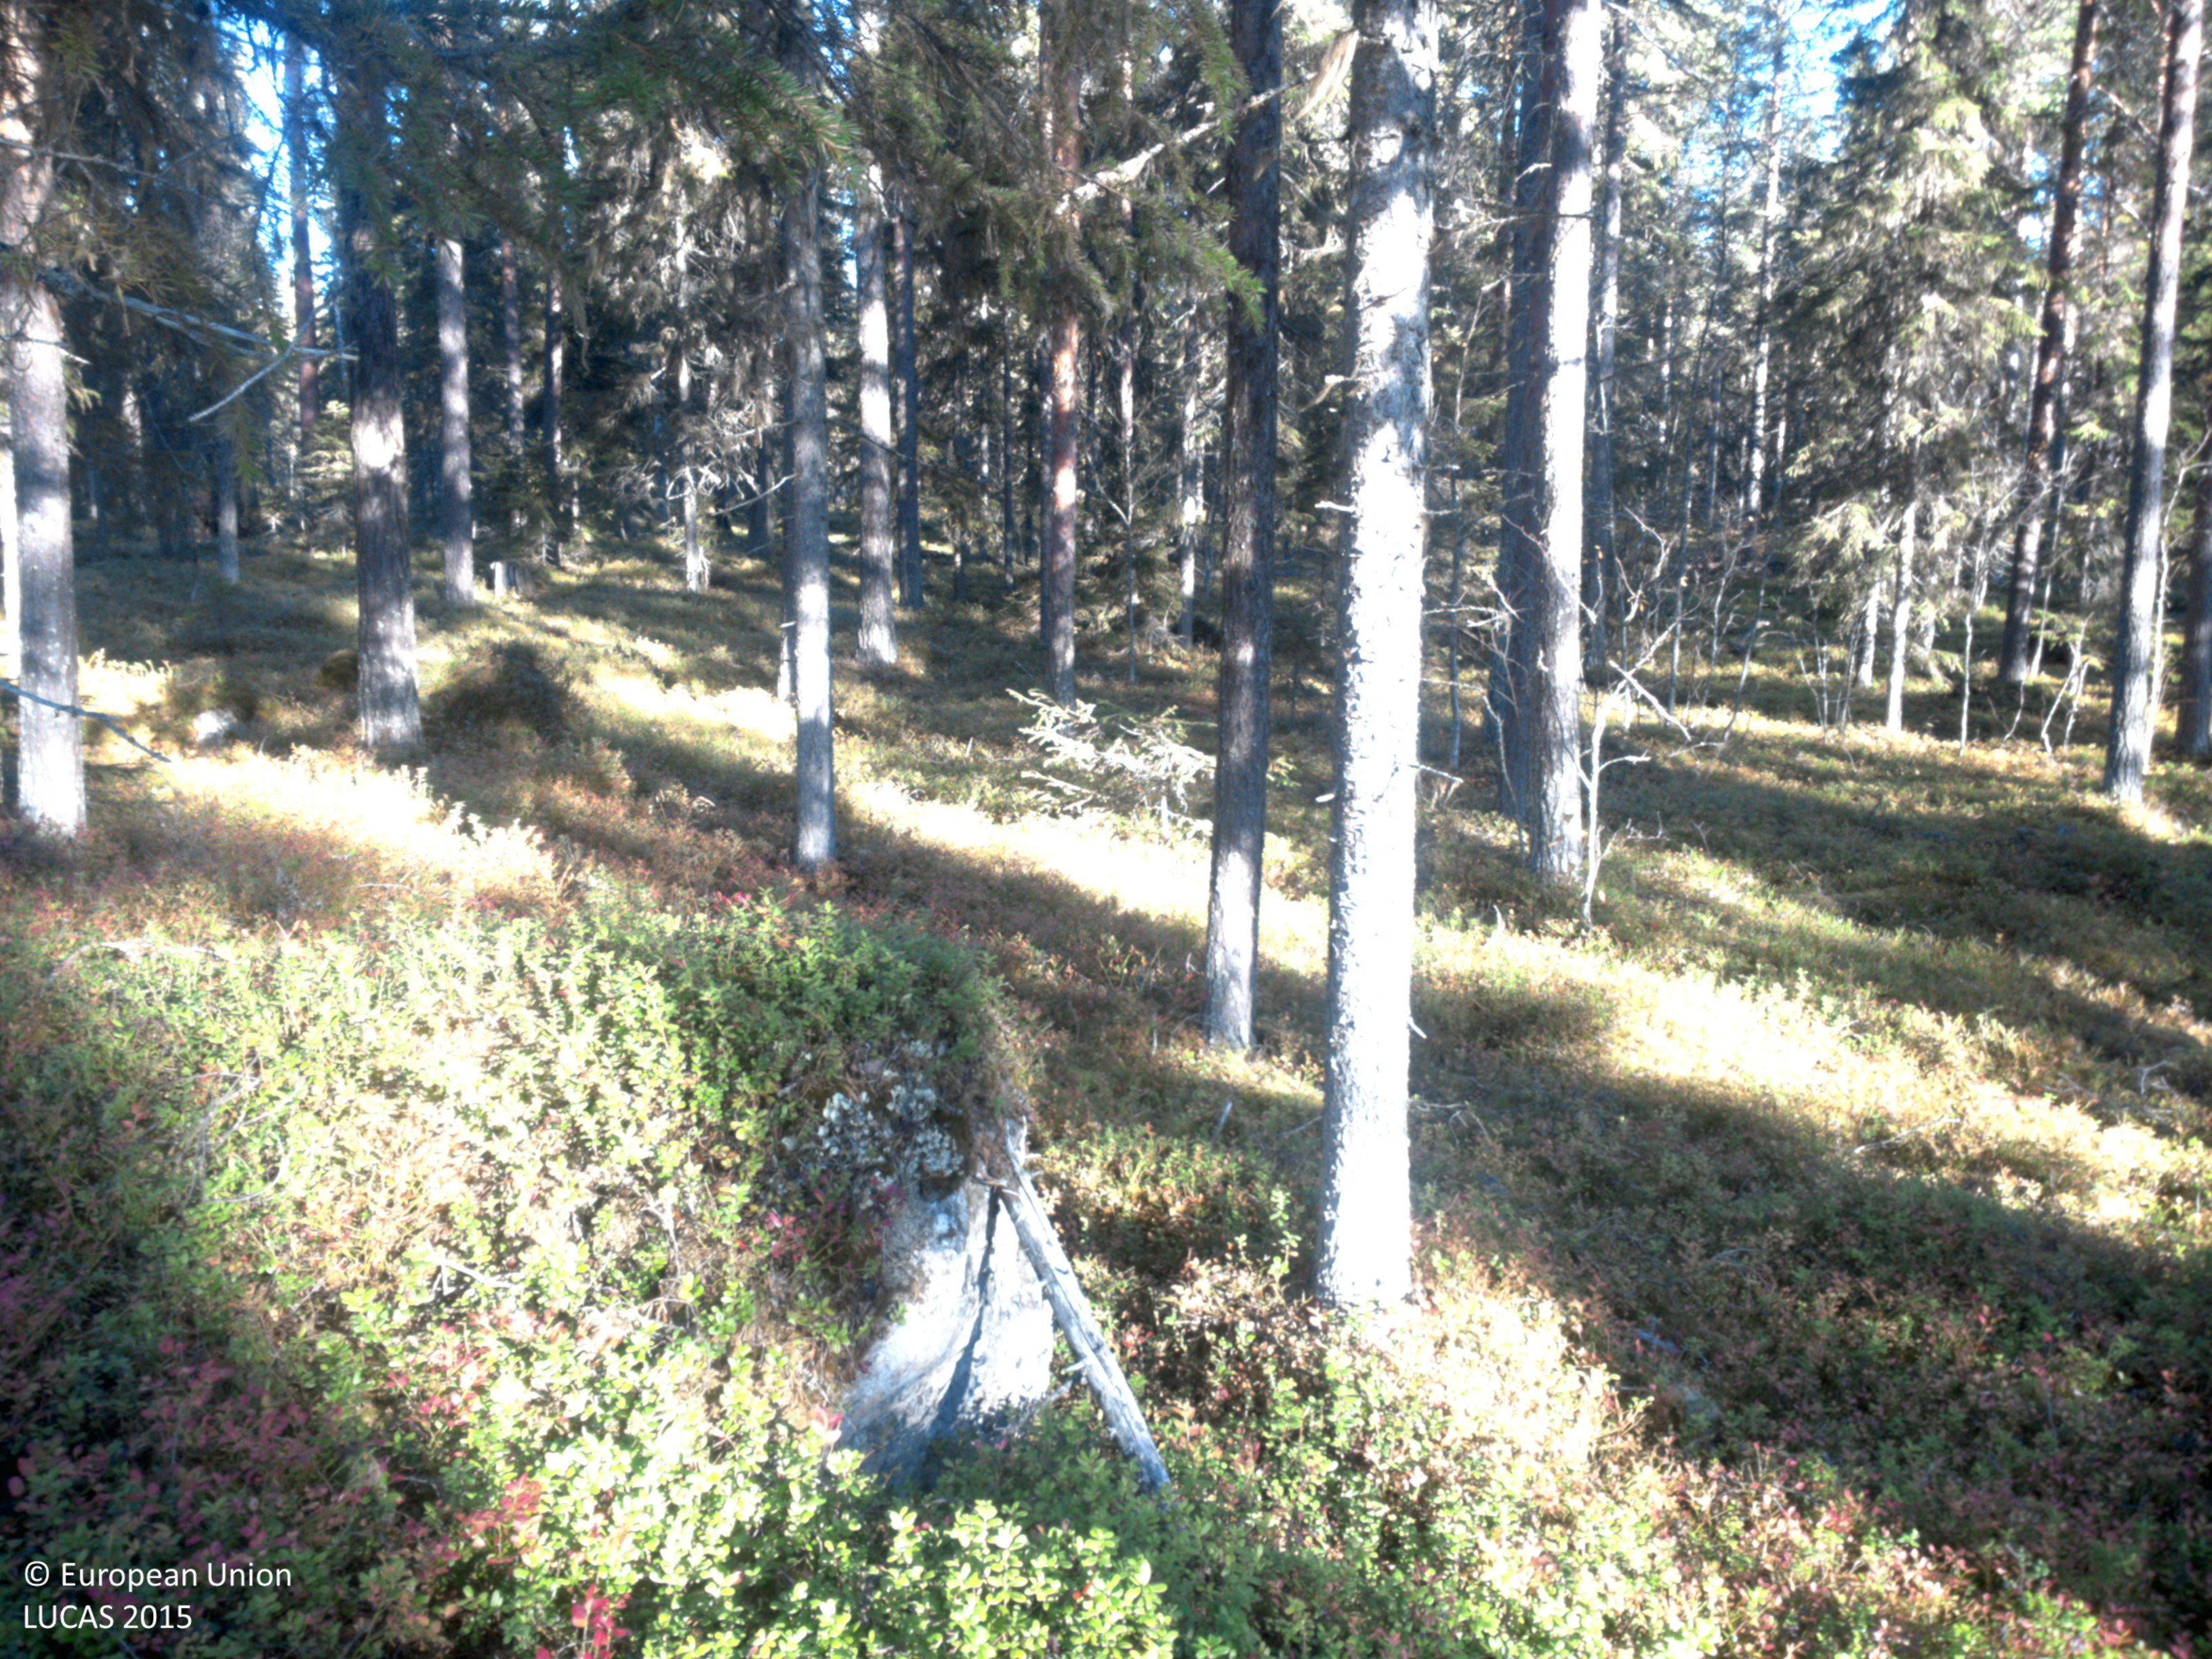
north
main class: Woodland
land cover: Other coniferous woodland
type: boreal forest
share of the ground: 50 - 75 %
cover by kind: coniferous forest trees 65 %, shrubs 20 %, lichens and mosses 10 %, herbaceous plants 5 %
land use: Forestry
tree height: > 5 m
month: October
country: SE
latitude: 64.7618
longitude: 18.3108
